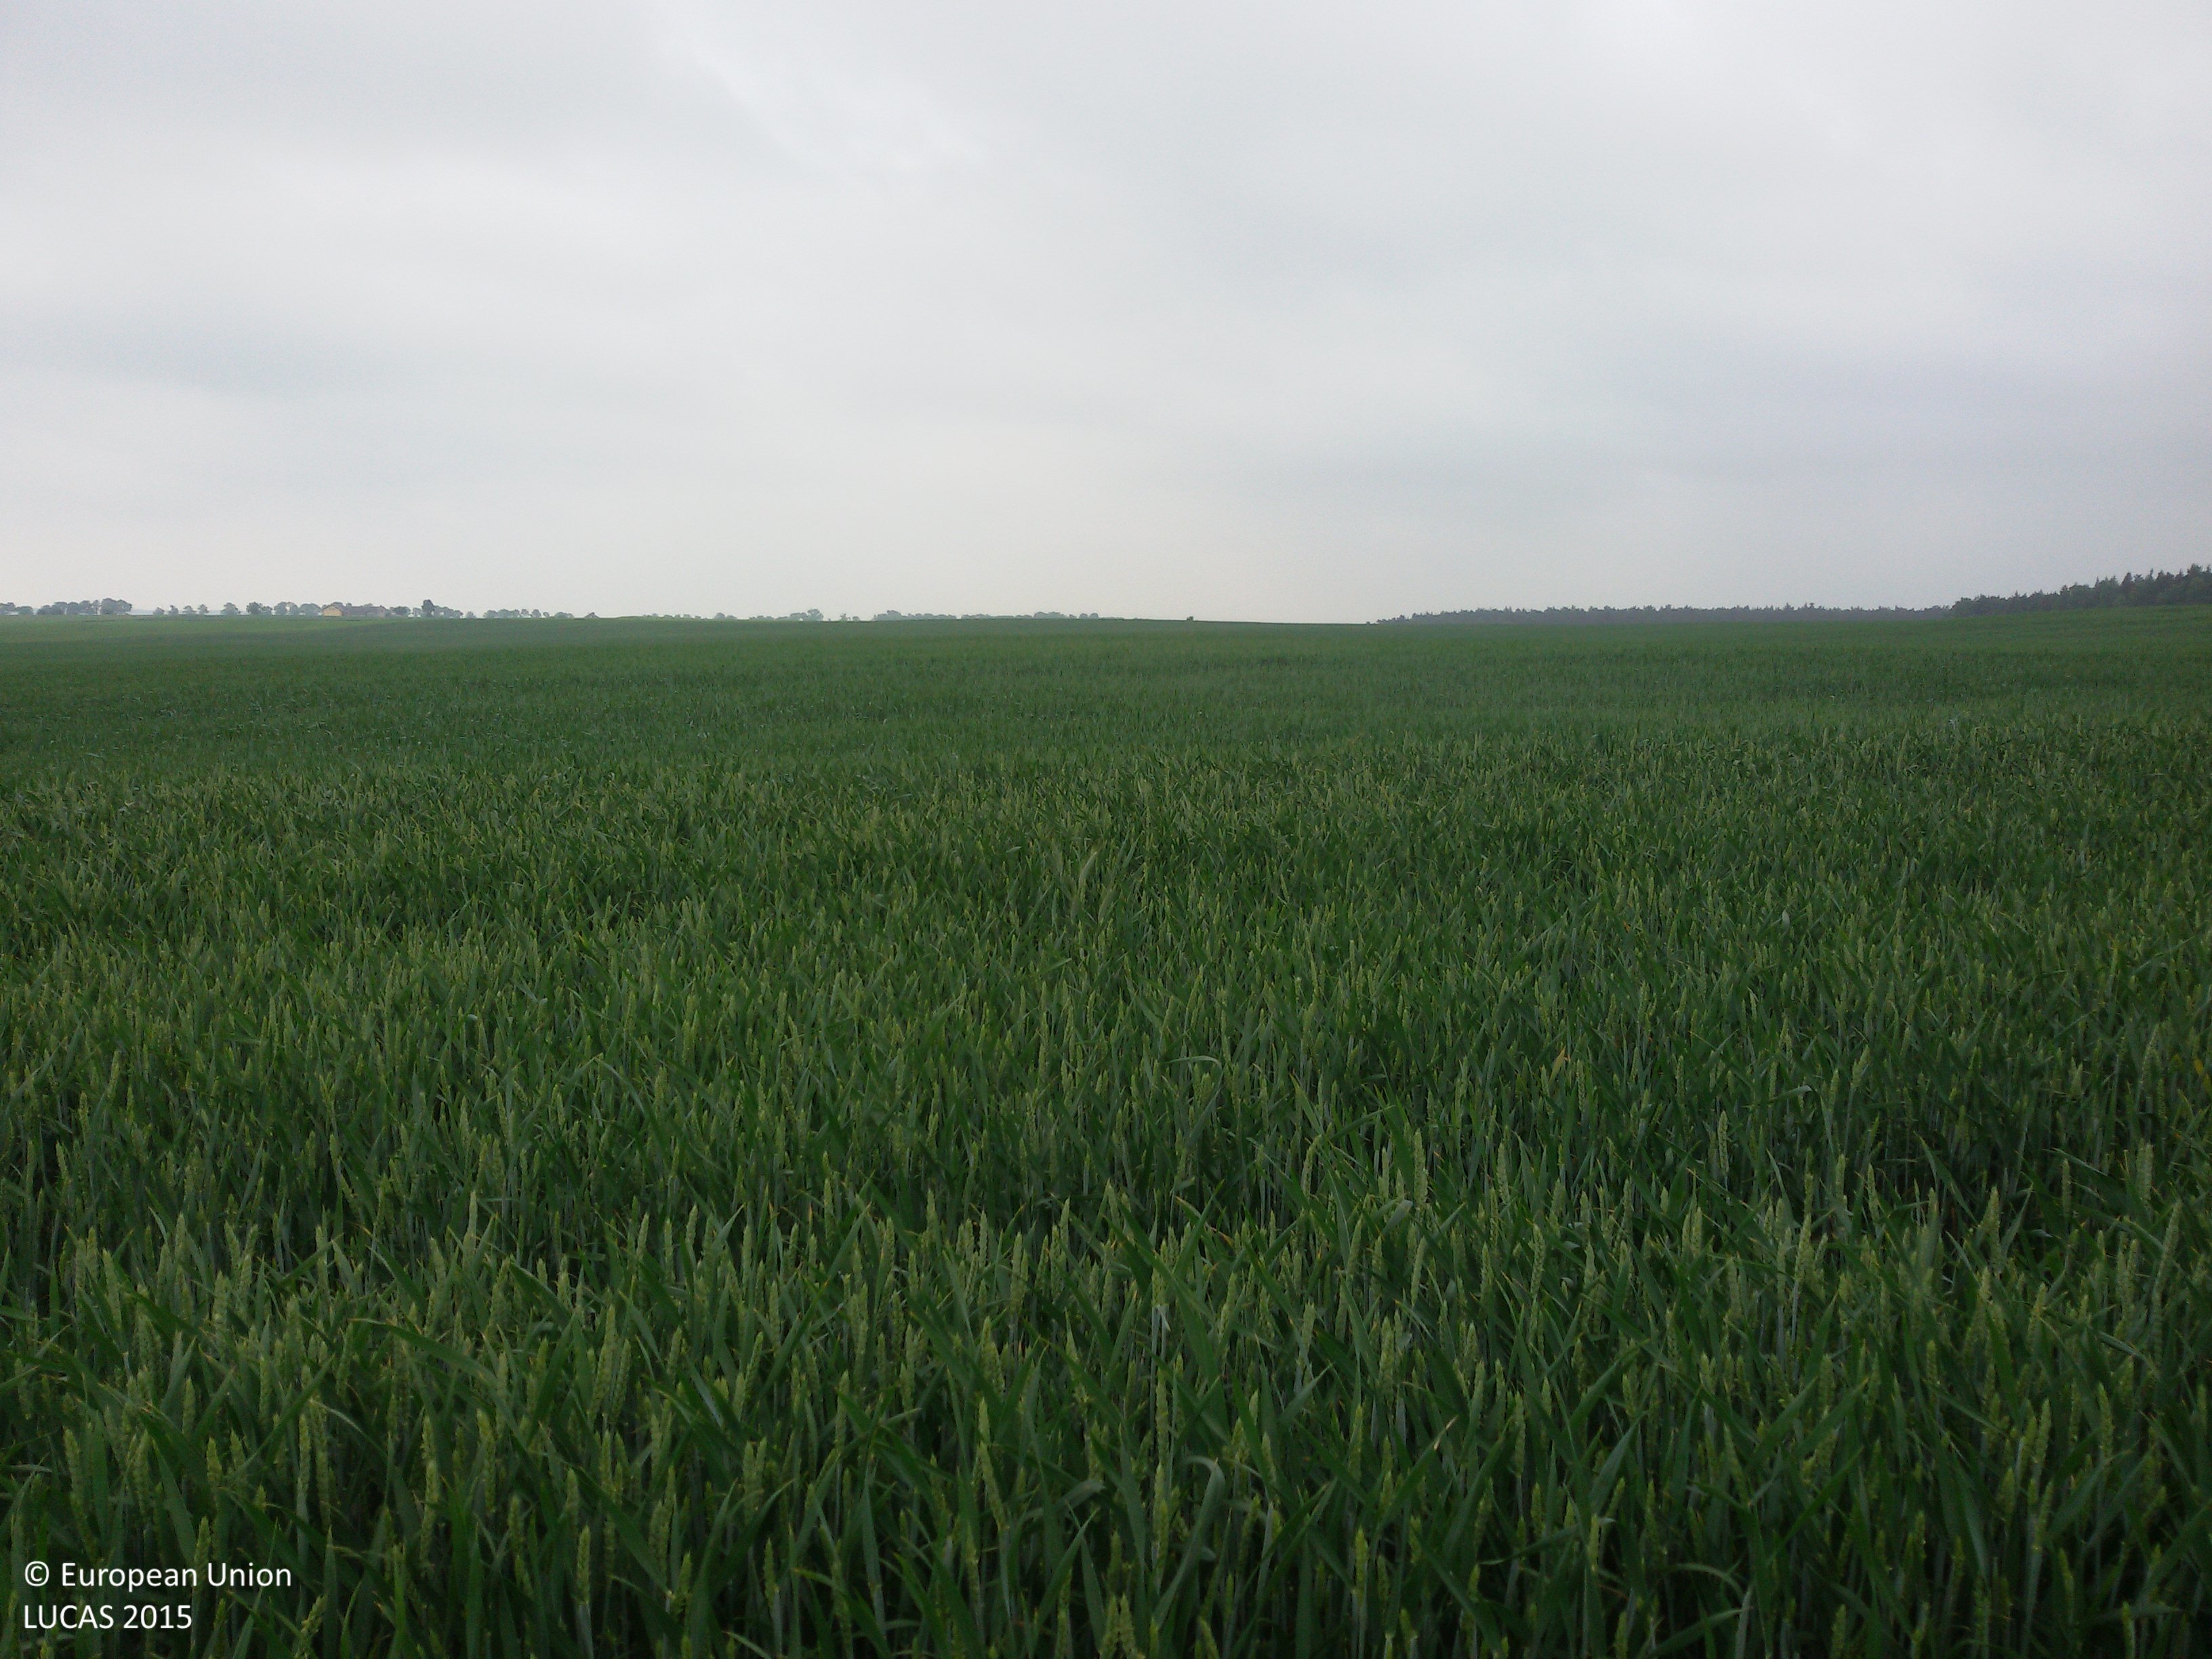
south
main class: Cropland
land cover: Common wheat
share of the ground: > 75 %
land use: Agriculture (excluding fallow land and kitchen gardens)
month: June
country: PL
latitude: 52.6822
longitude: 18.0478
